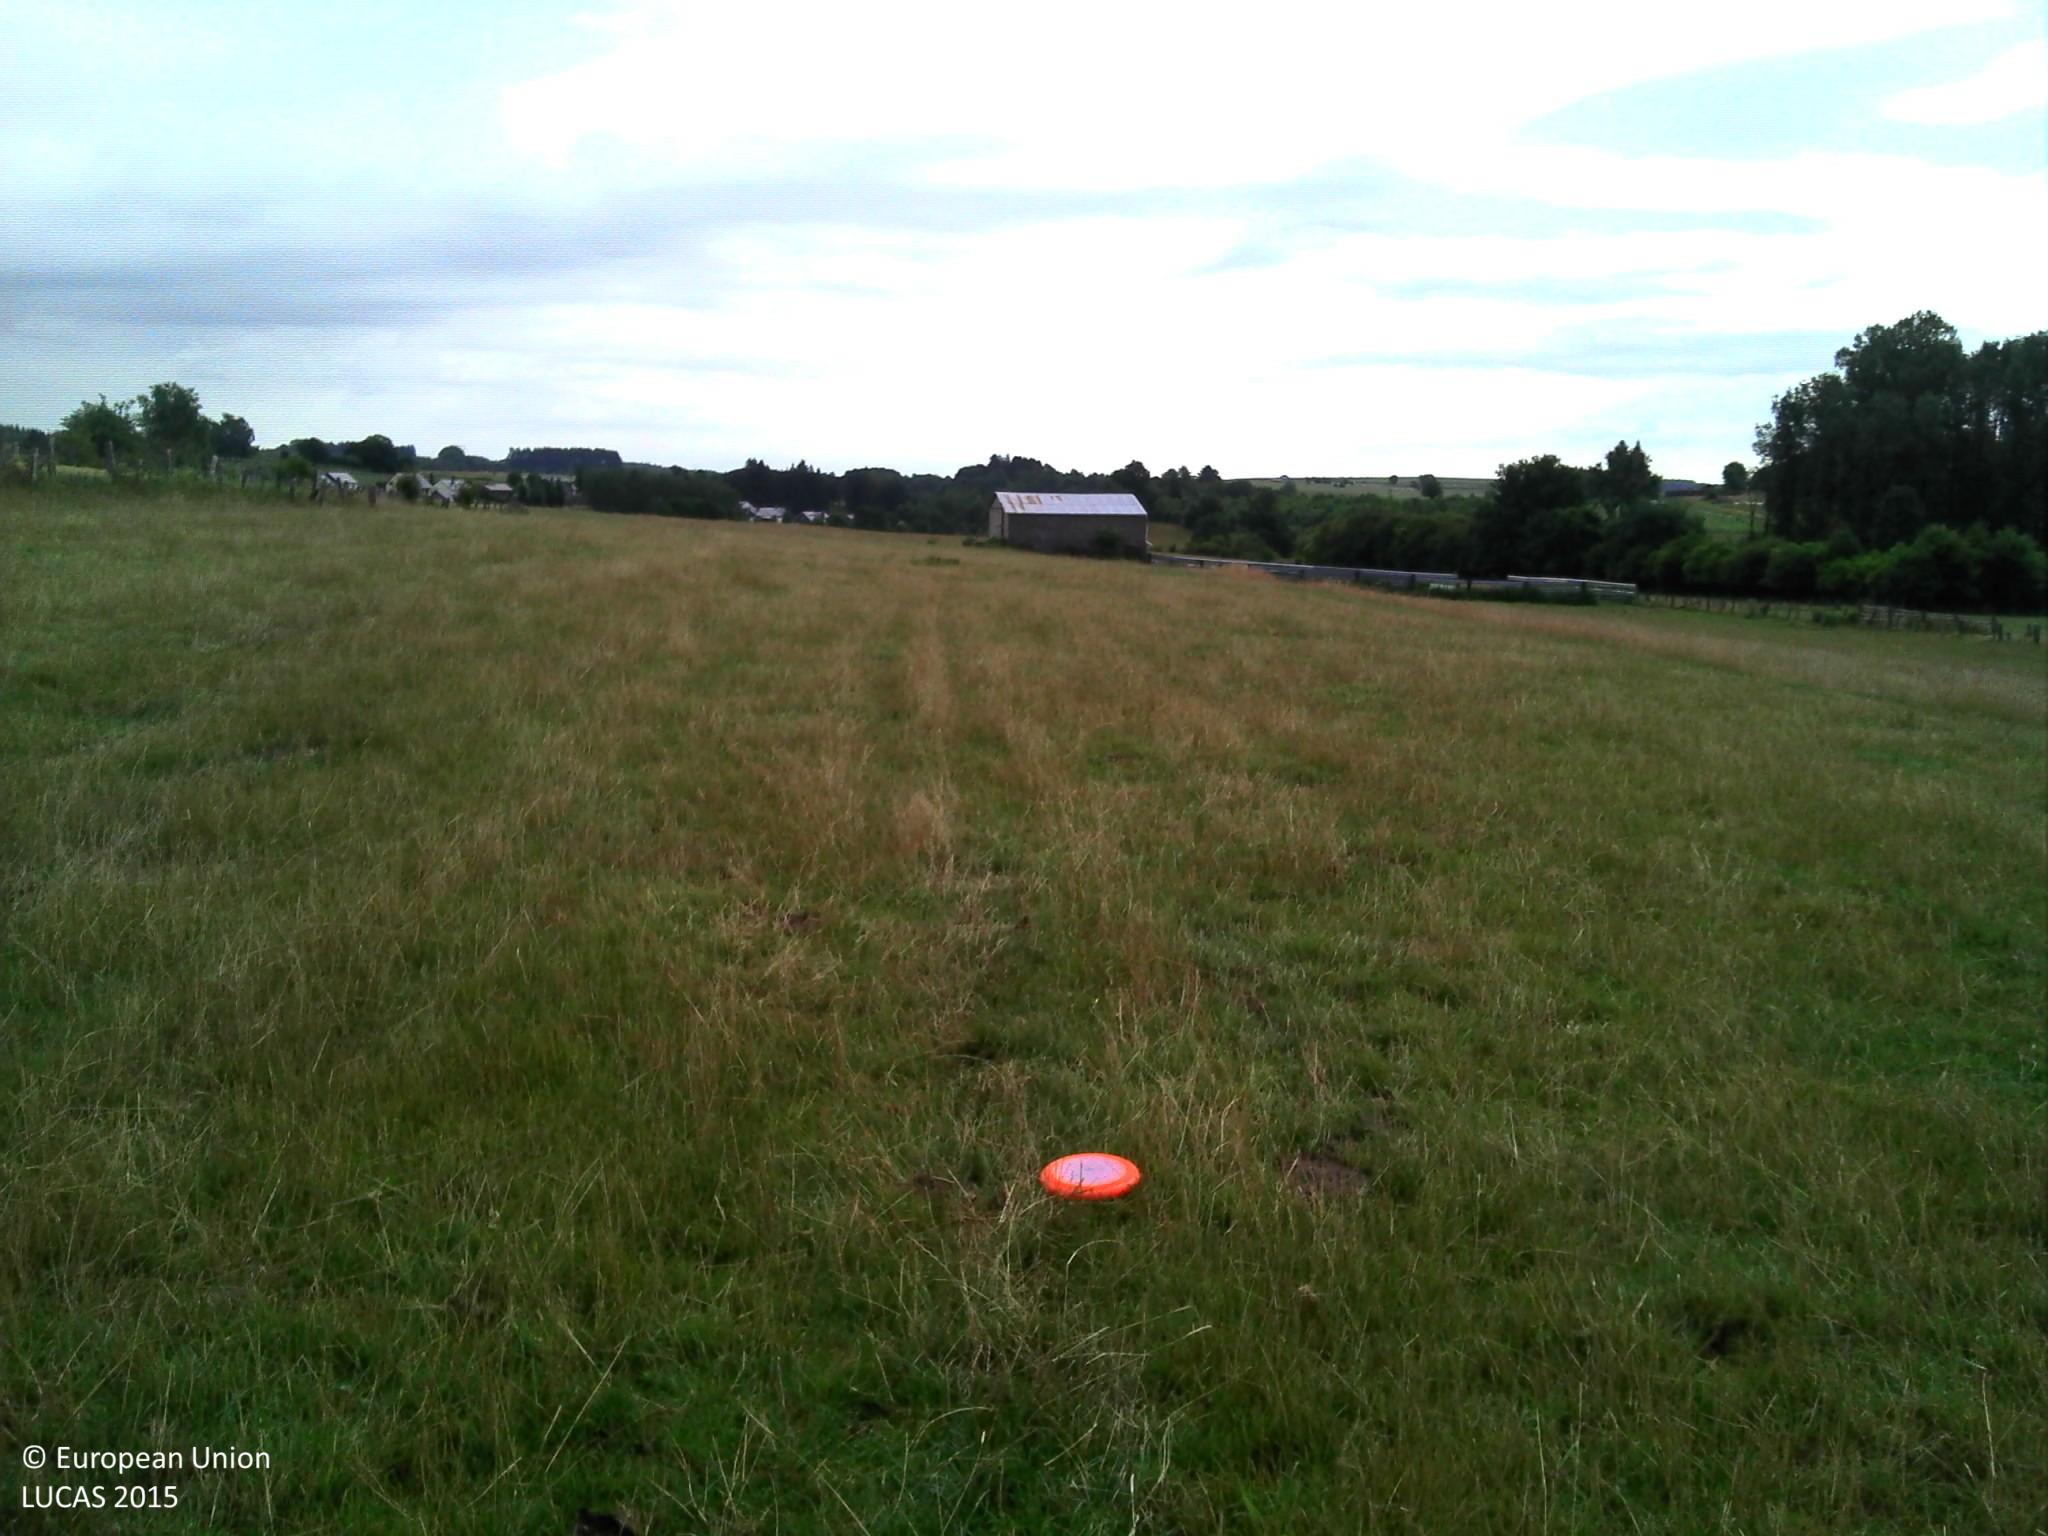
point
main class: Grassland
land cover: Grassland without tree/shrub cover
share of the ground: > 75 %
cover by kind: herbaceous plants 100 %
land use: Agriculture (excluding fallow land and kitchen gardens)
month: July
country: BE
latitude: 49.8346
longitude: 5.2848
